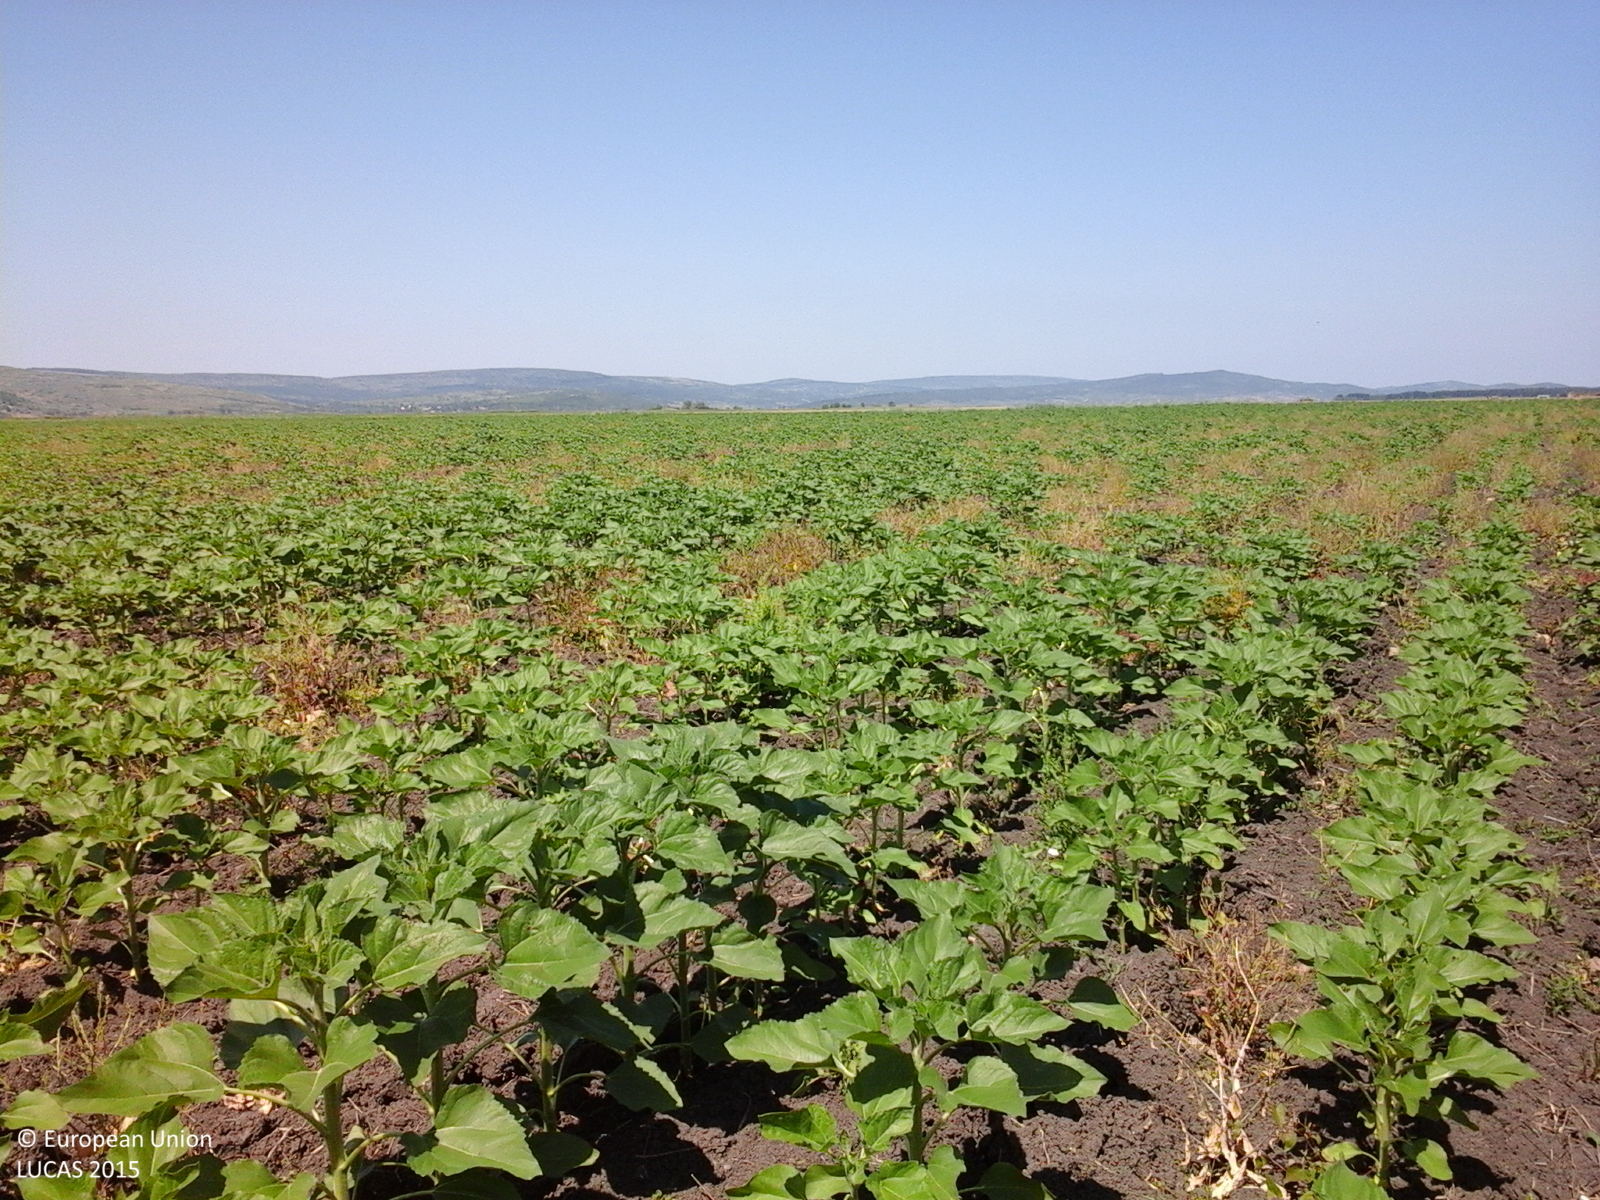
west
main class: Cropland
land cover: Sunflower
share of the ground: > 75 %
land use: Agriculture (excluding fallow land and kitchen gardens)
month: June
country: RO
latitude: 47.0316
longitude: 27.9325
